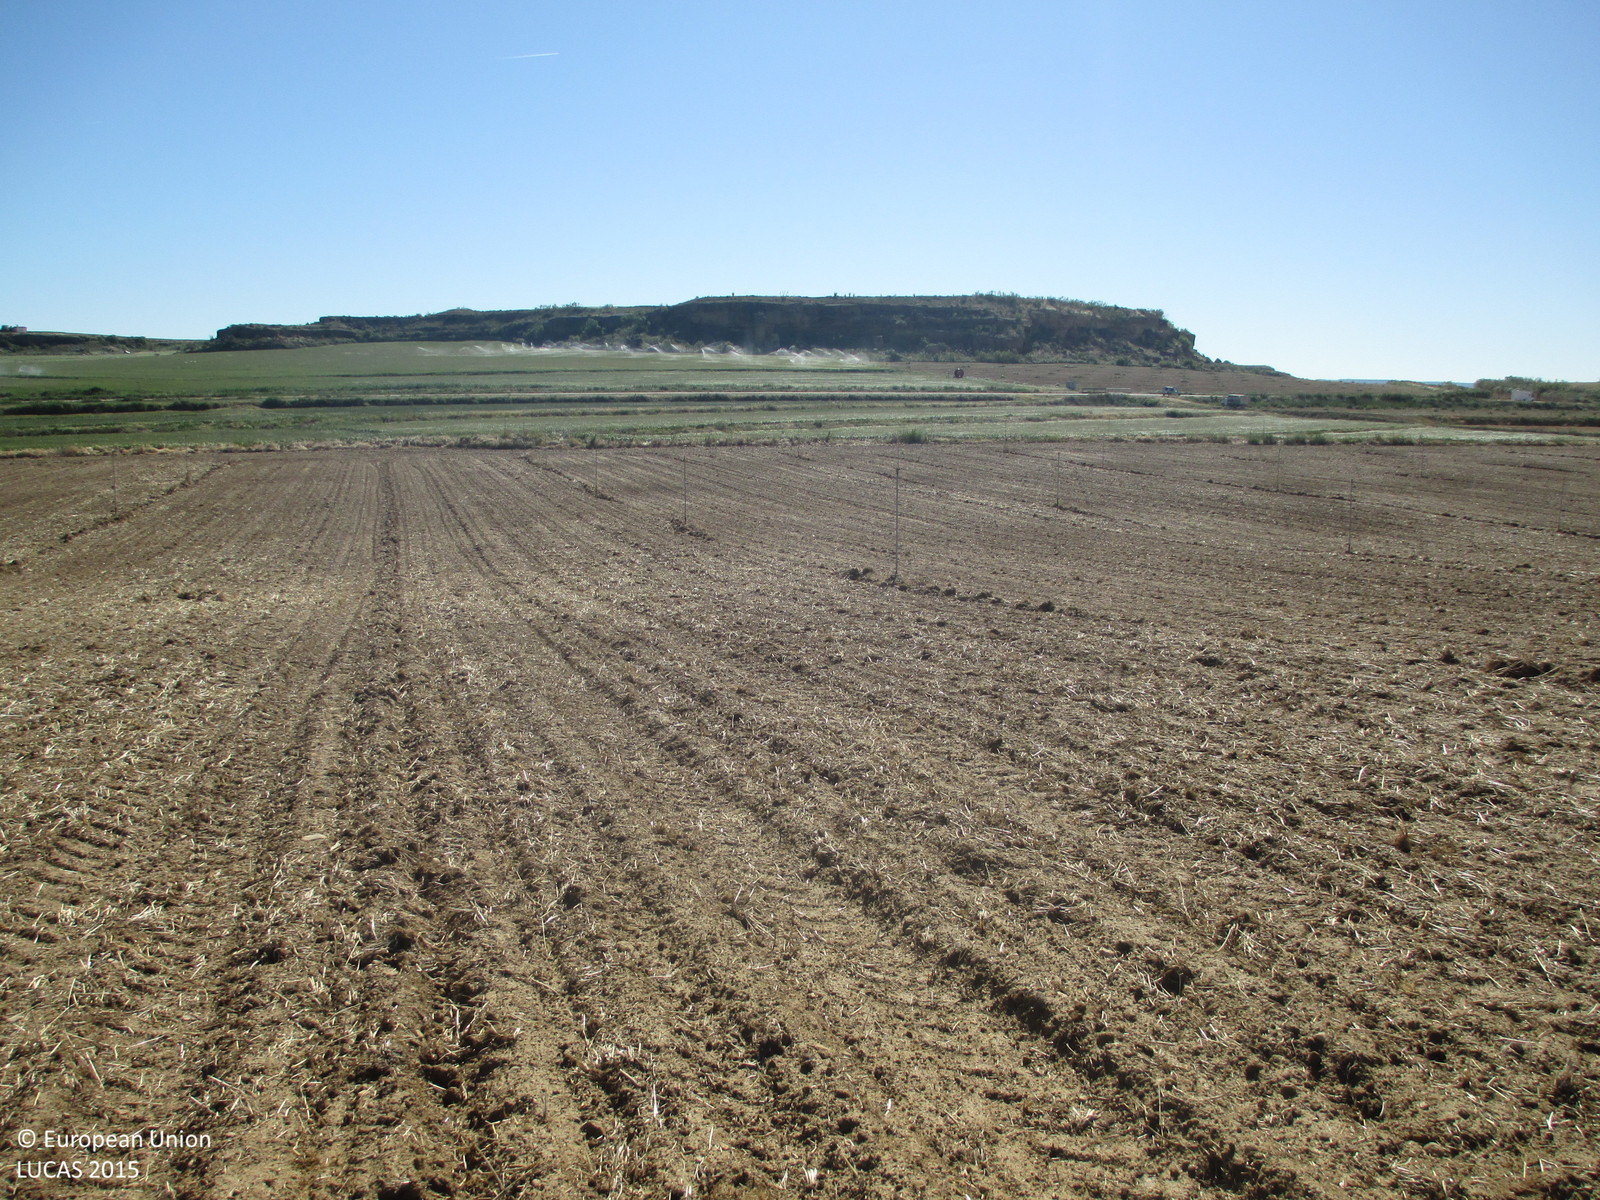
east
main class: Cropland
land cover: Maize
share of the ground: < 10 %
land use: Agriculture (excluding fallow land and kitchen gardens)
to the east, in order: Maize; Shruby margins; Barley; Shruby margins; Barley; Shruby margins; Barley; Shruby margins; Barley; Grass margins; Paved roads, cycling and walking lanes; Inland fresh running water
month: May
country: ES
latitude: 41.9008
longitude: -0.2049
